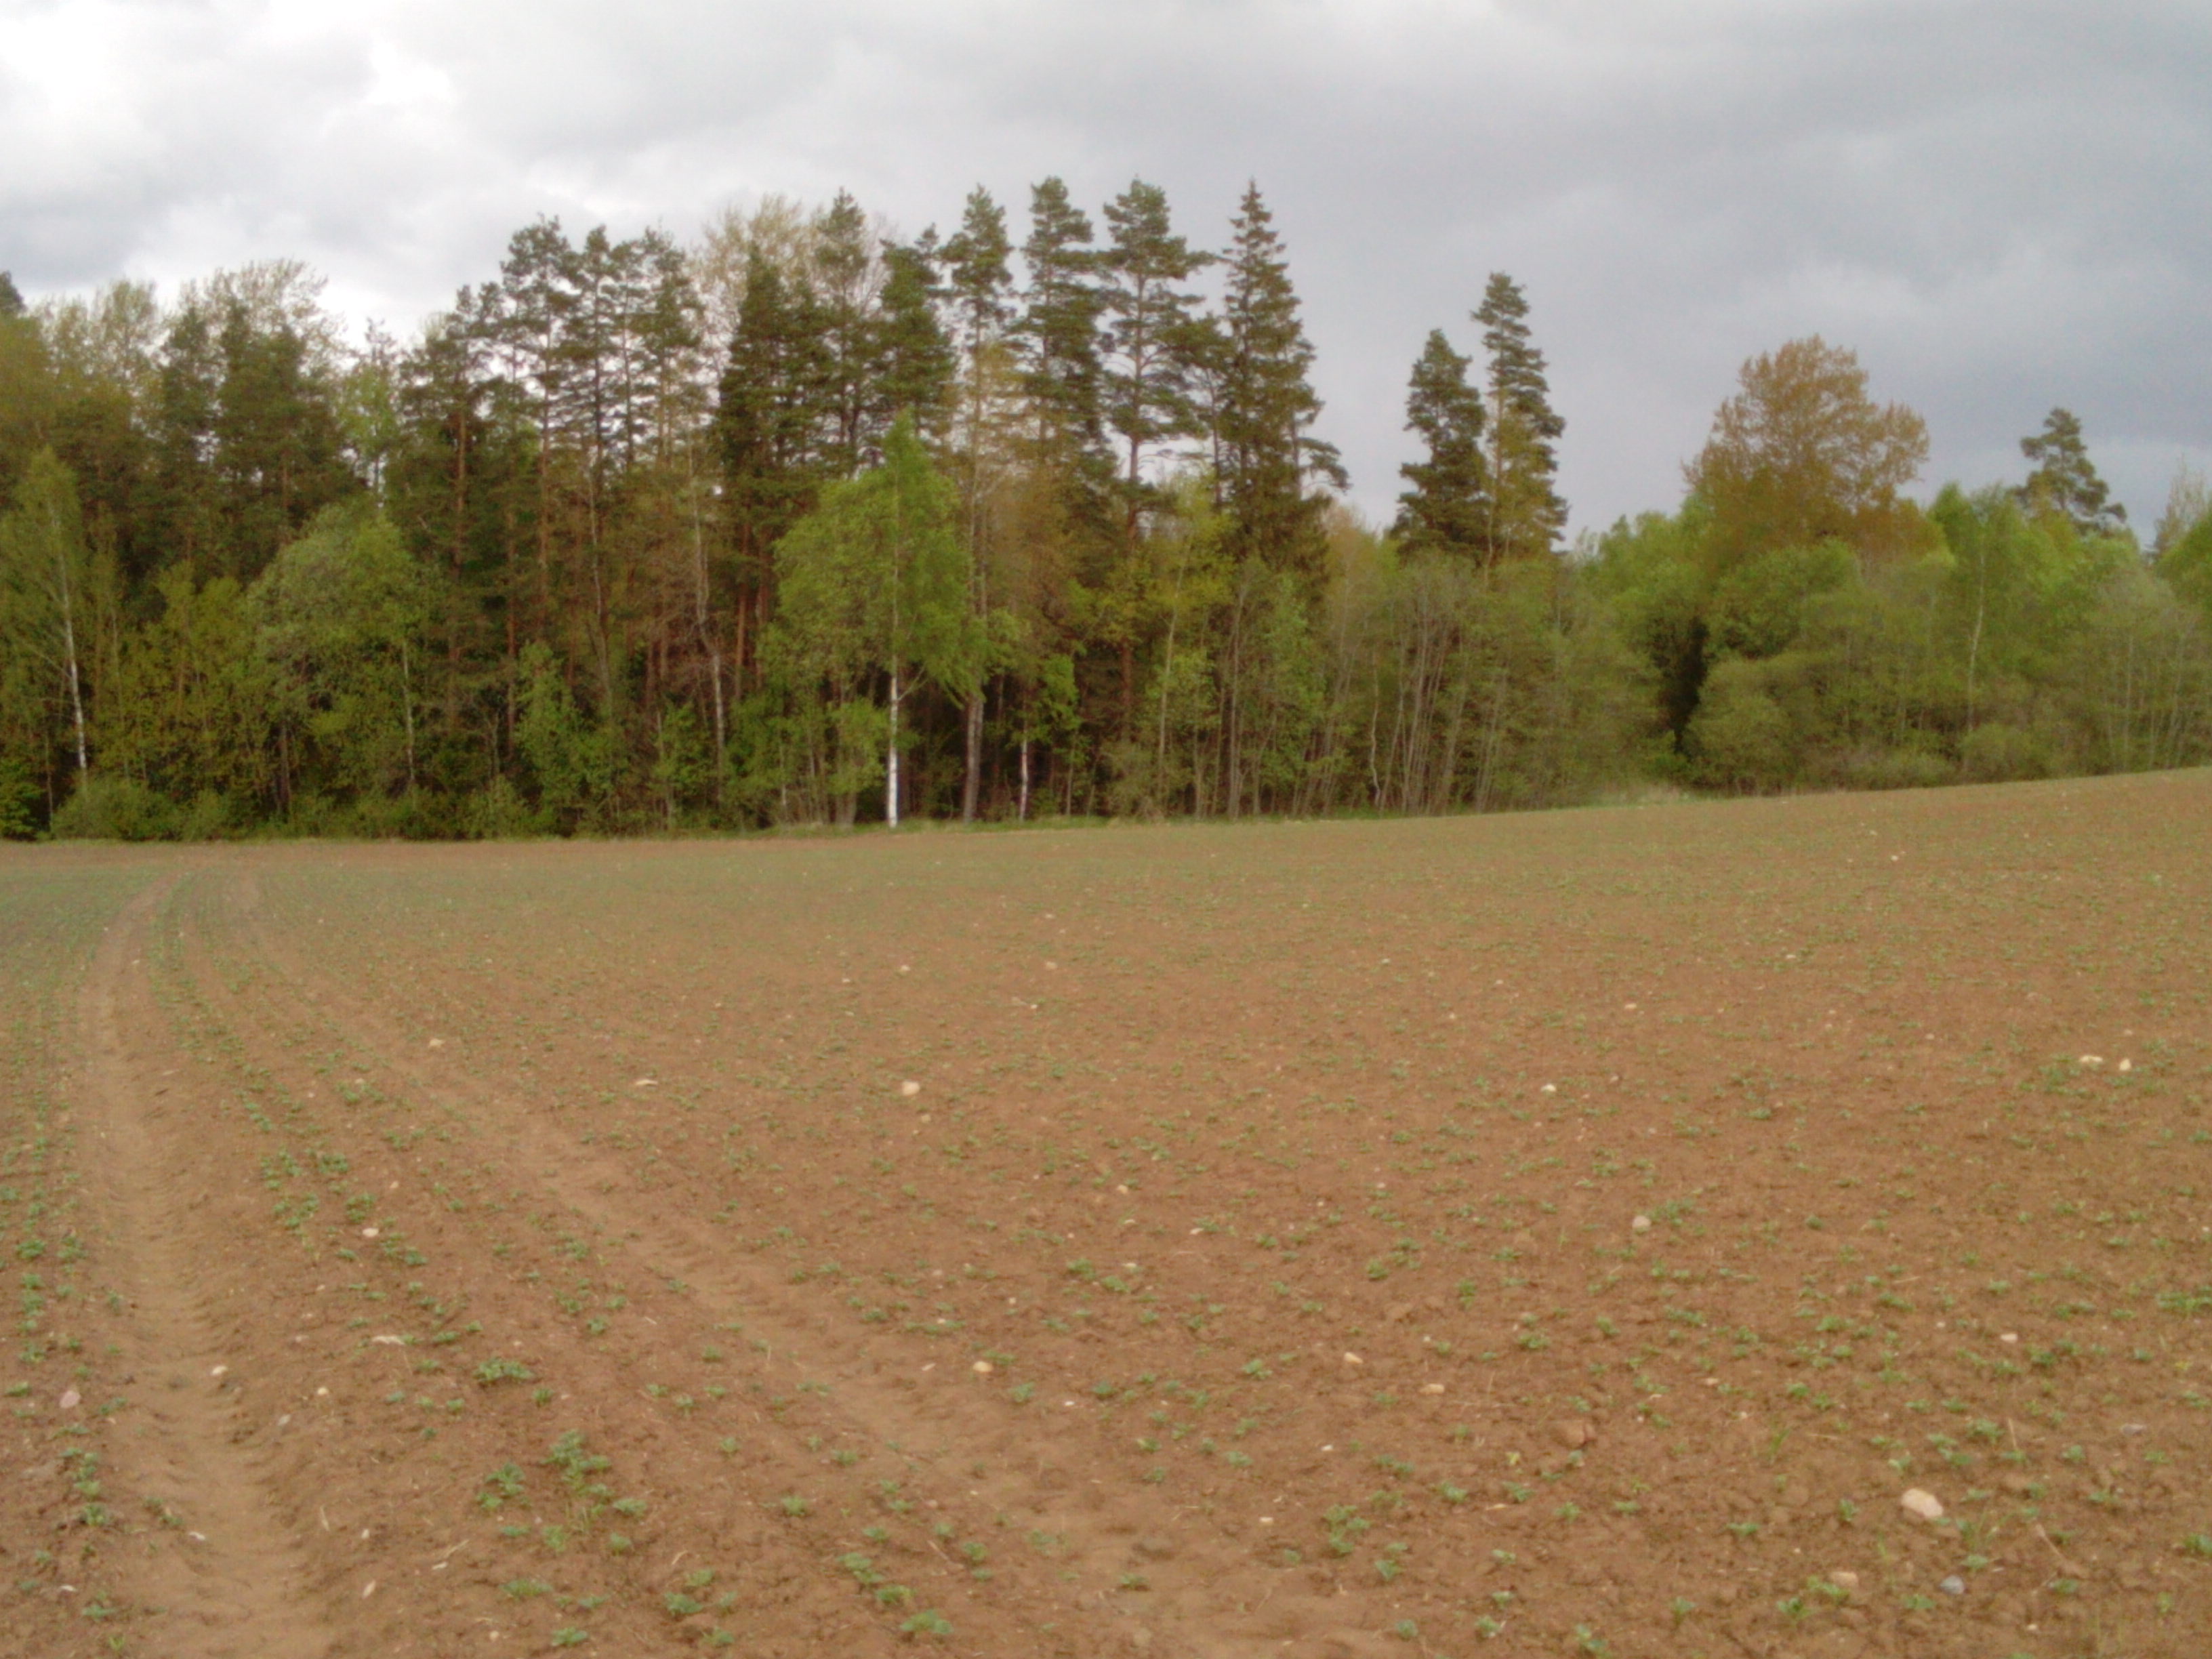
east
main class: Cropland
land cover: Dry pulses
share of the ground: 10 - 25 %
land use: Agriculture (excluding fallow land and kitchen gardens)
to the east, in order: Dry pulses; Grass margins; Ditches and canals; Abandoned hedges; Grassland without tree/shrub cover
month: May
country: LV
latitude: 56.7581
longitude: 22.8697
